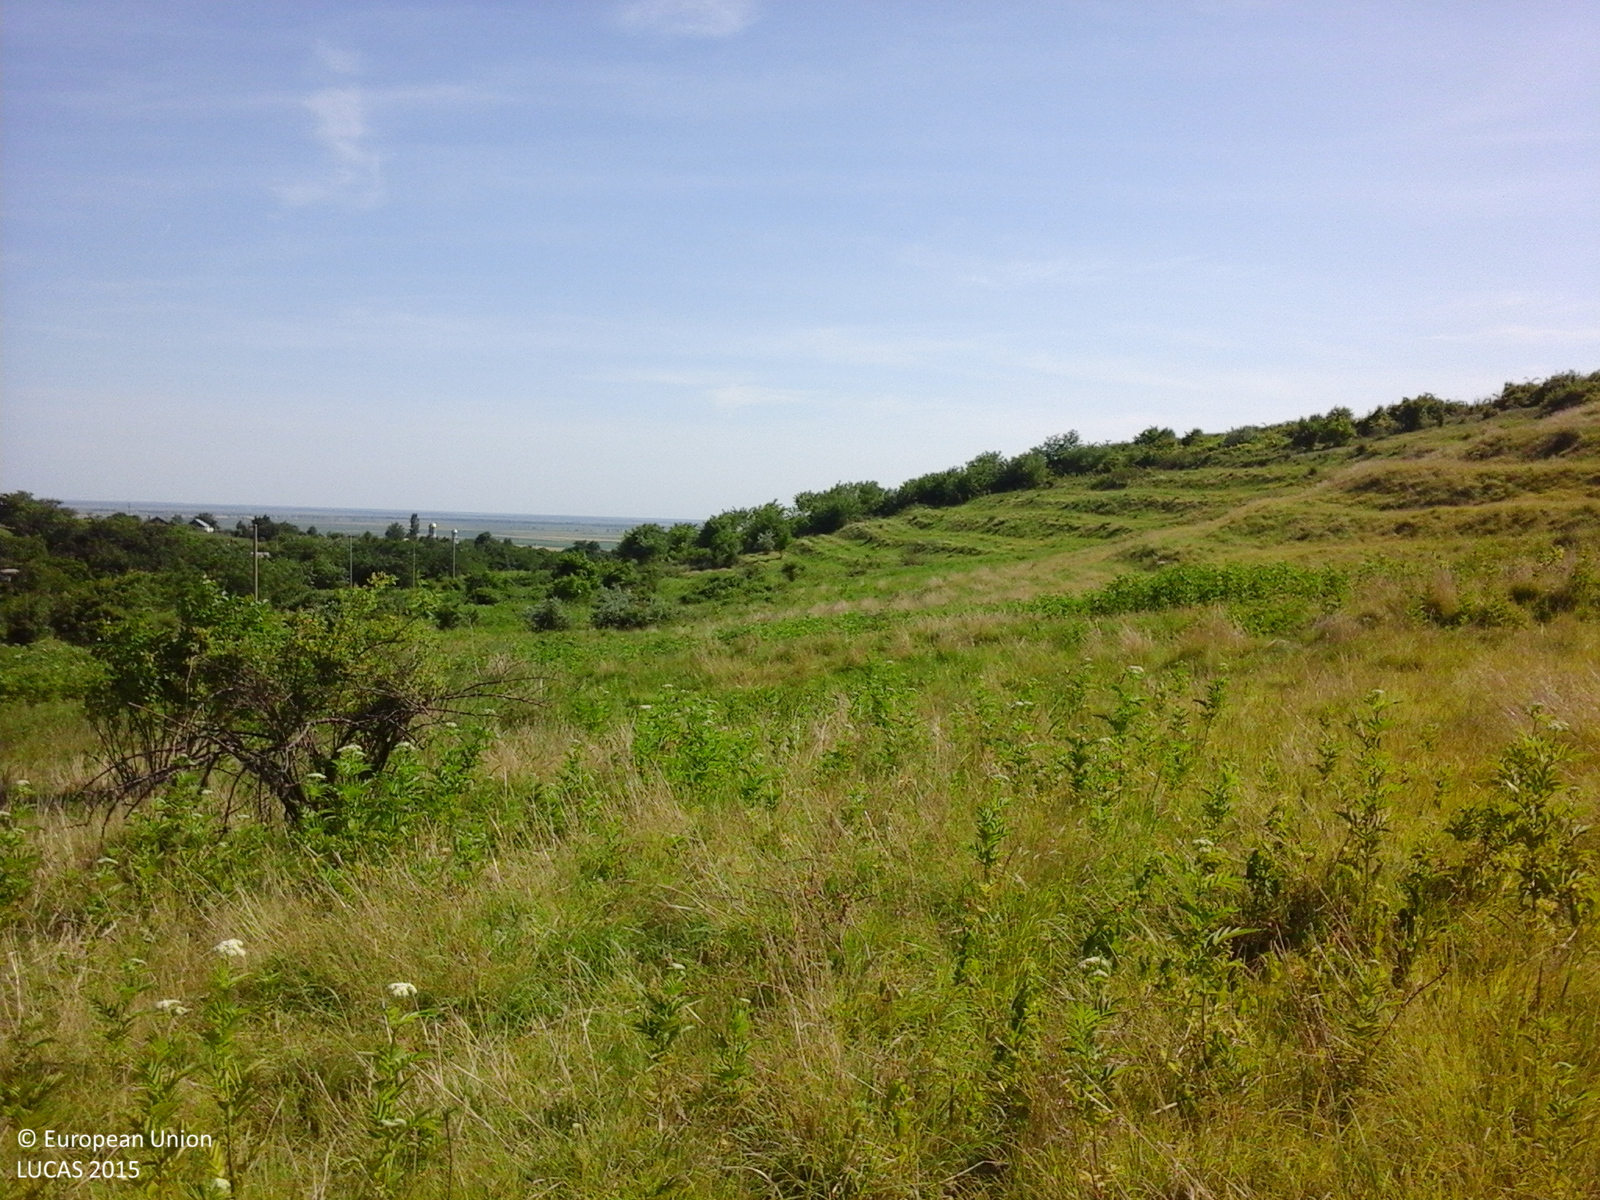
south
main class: Grassland
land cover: Grassland with sparse tree/shrub cover
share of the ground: > 75 %
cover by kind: herbaceous plants 90 %, coniferous forest trees 5 %, shrubs 5 %
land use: Agriculture (excluding fallow land and kitchen gardens)
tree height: < 5 m
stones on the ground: < 10 %
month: June
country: RO
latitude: 45.0038
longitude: 26.2650
